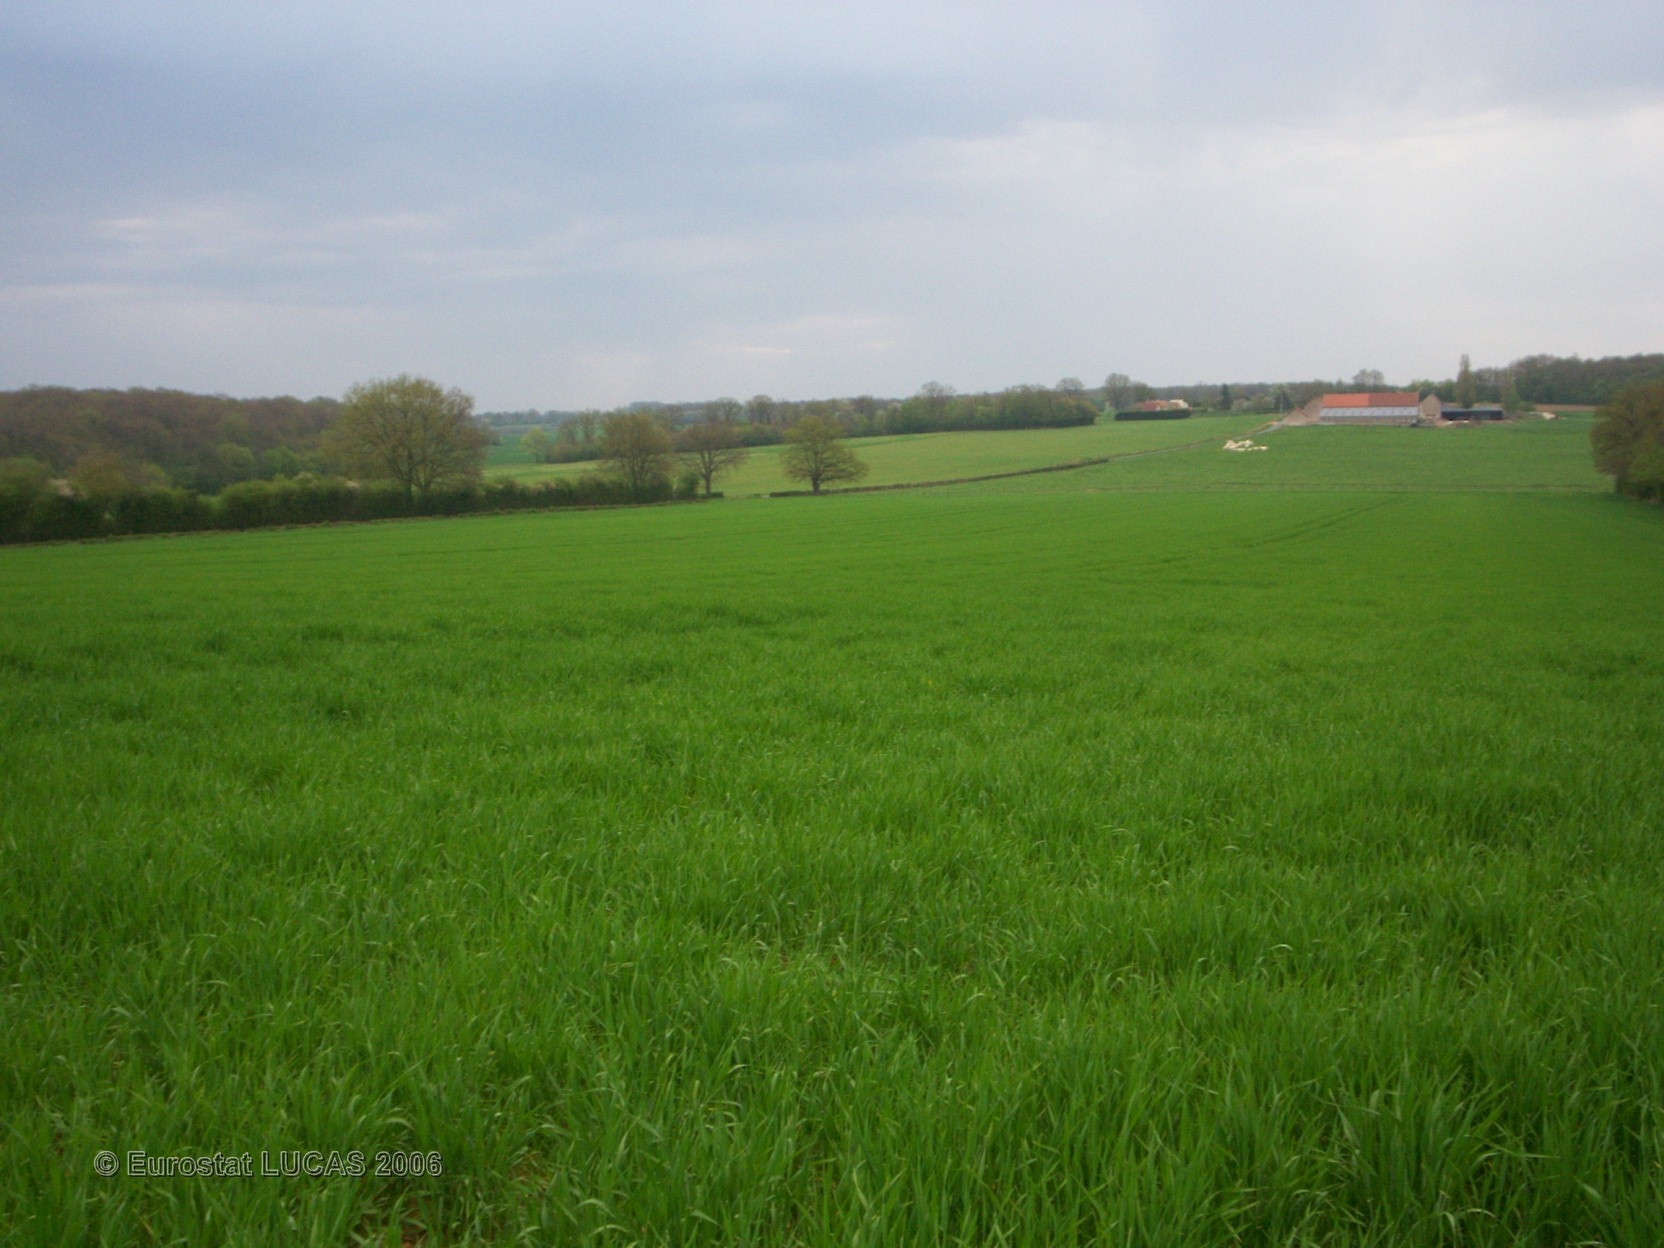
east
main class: Cropland
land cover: Barley
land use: Agriculture (excluding fallow land and kitchen gardens)
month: April
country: FR
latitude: 47.4738
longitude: 2.9485
